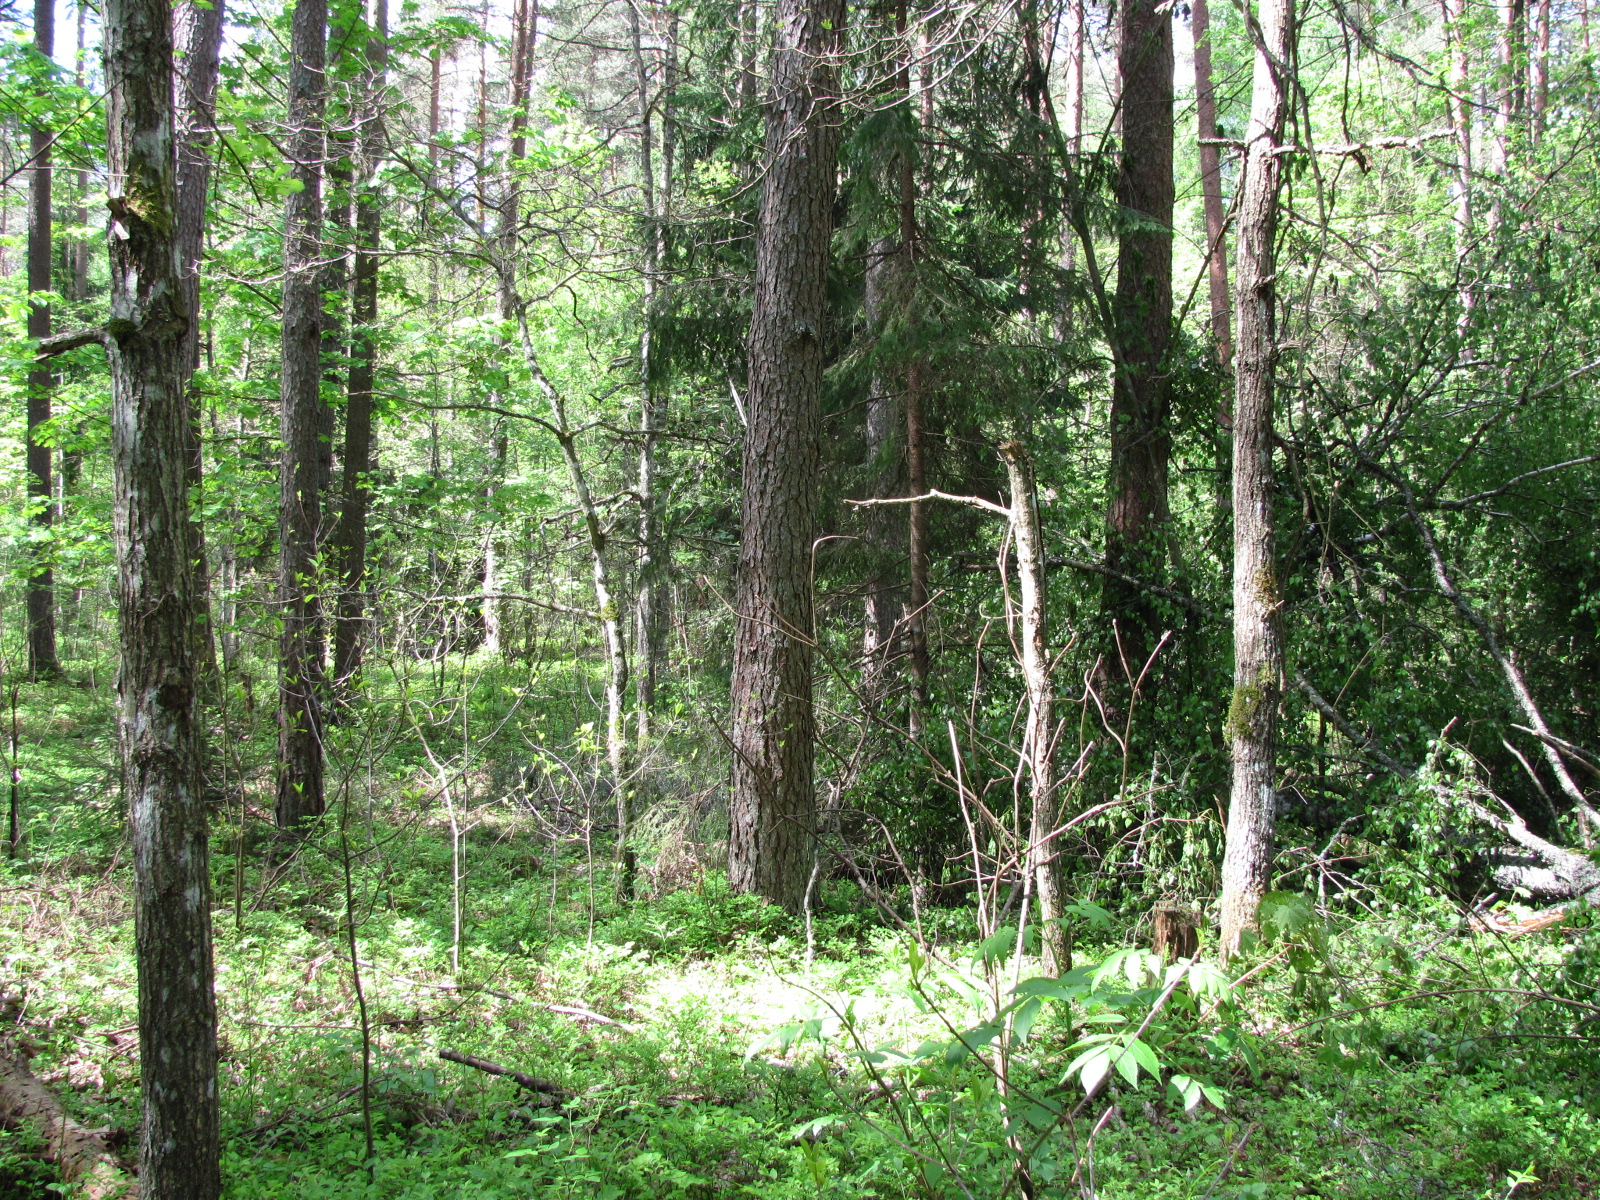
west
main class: Woodland
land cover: Other mixed woodland
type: hemiboreal forest and nemoral coniferous forest and mixed broadleaved-coniferous forest
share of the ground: > 75 %
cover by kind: coniferous forest trees 70 %, broadleaved forest trees 25 %, herbaceous plants 5 %
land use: Forestry
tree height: > 5 m
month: May
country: LV
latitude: 56.8090
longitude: 24.4578
